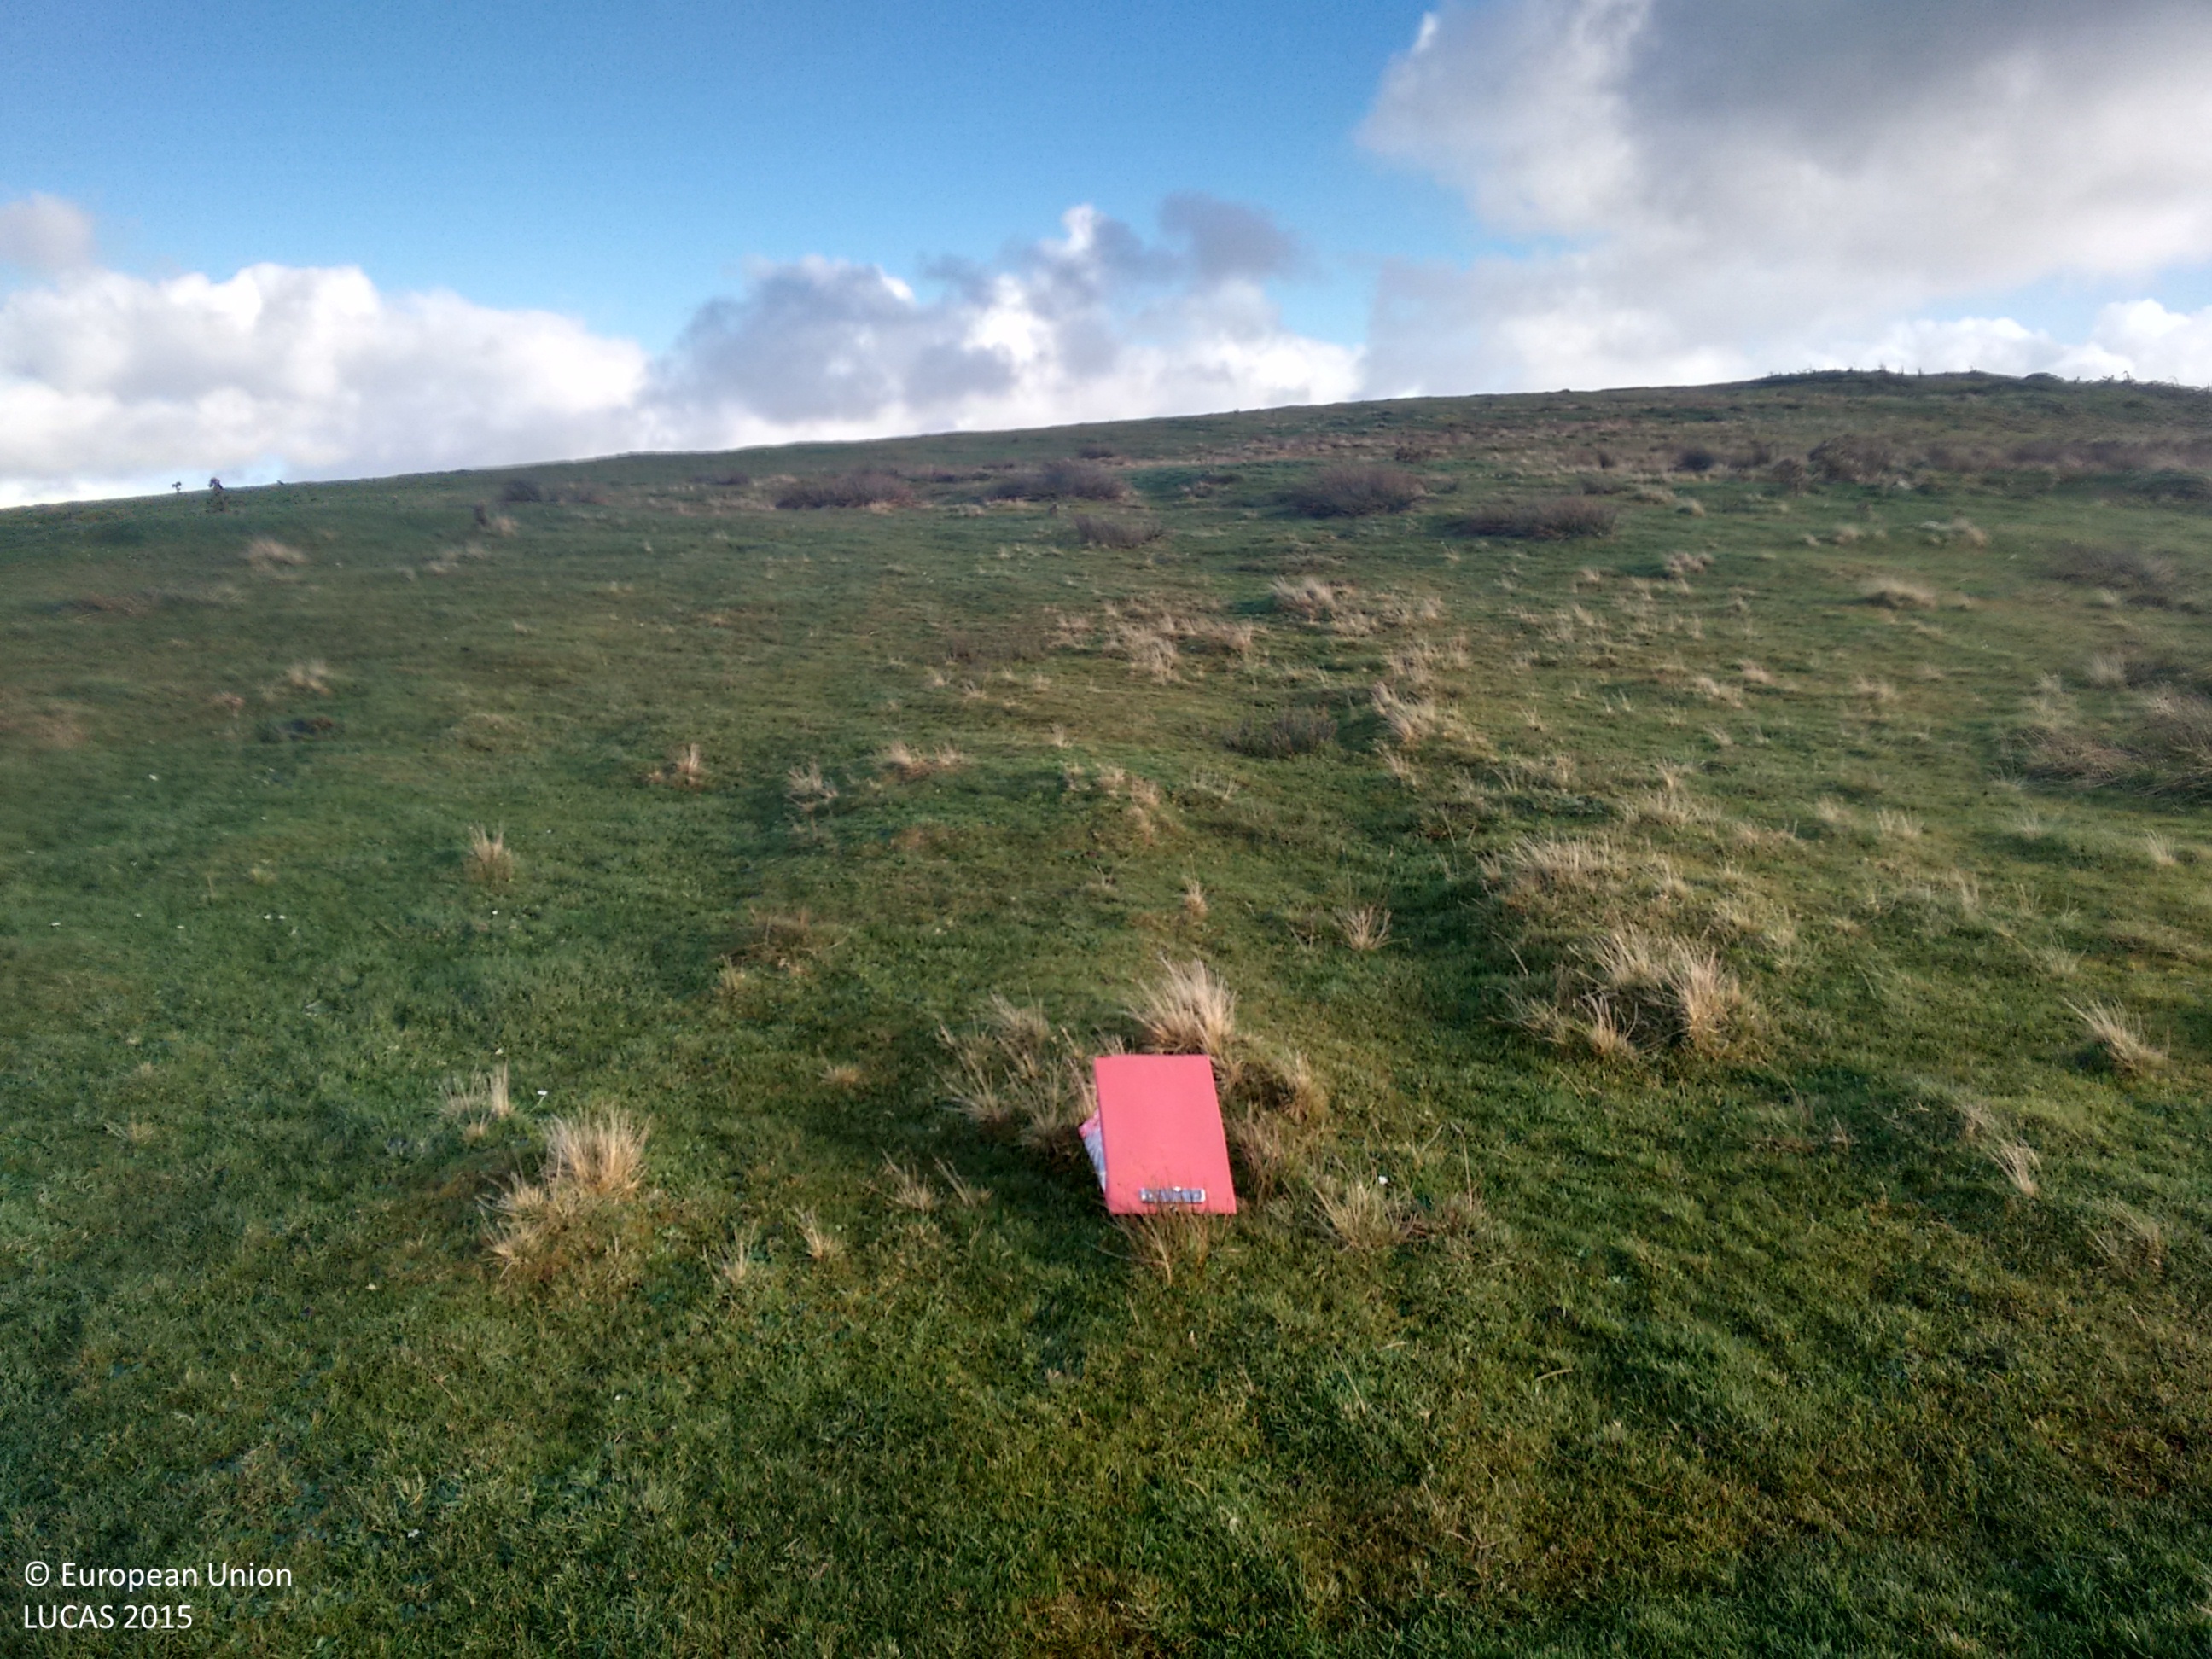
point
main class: Grassland
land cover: Grassland without tree/shrub cover
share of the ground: > 75 %
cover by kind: herbaceous plants 100 %
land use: Agriculture (excluding fallow land and kitchen gardens)
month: November
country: GB
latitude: 58.9946
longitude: -3.3382
